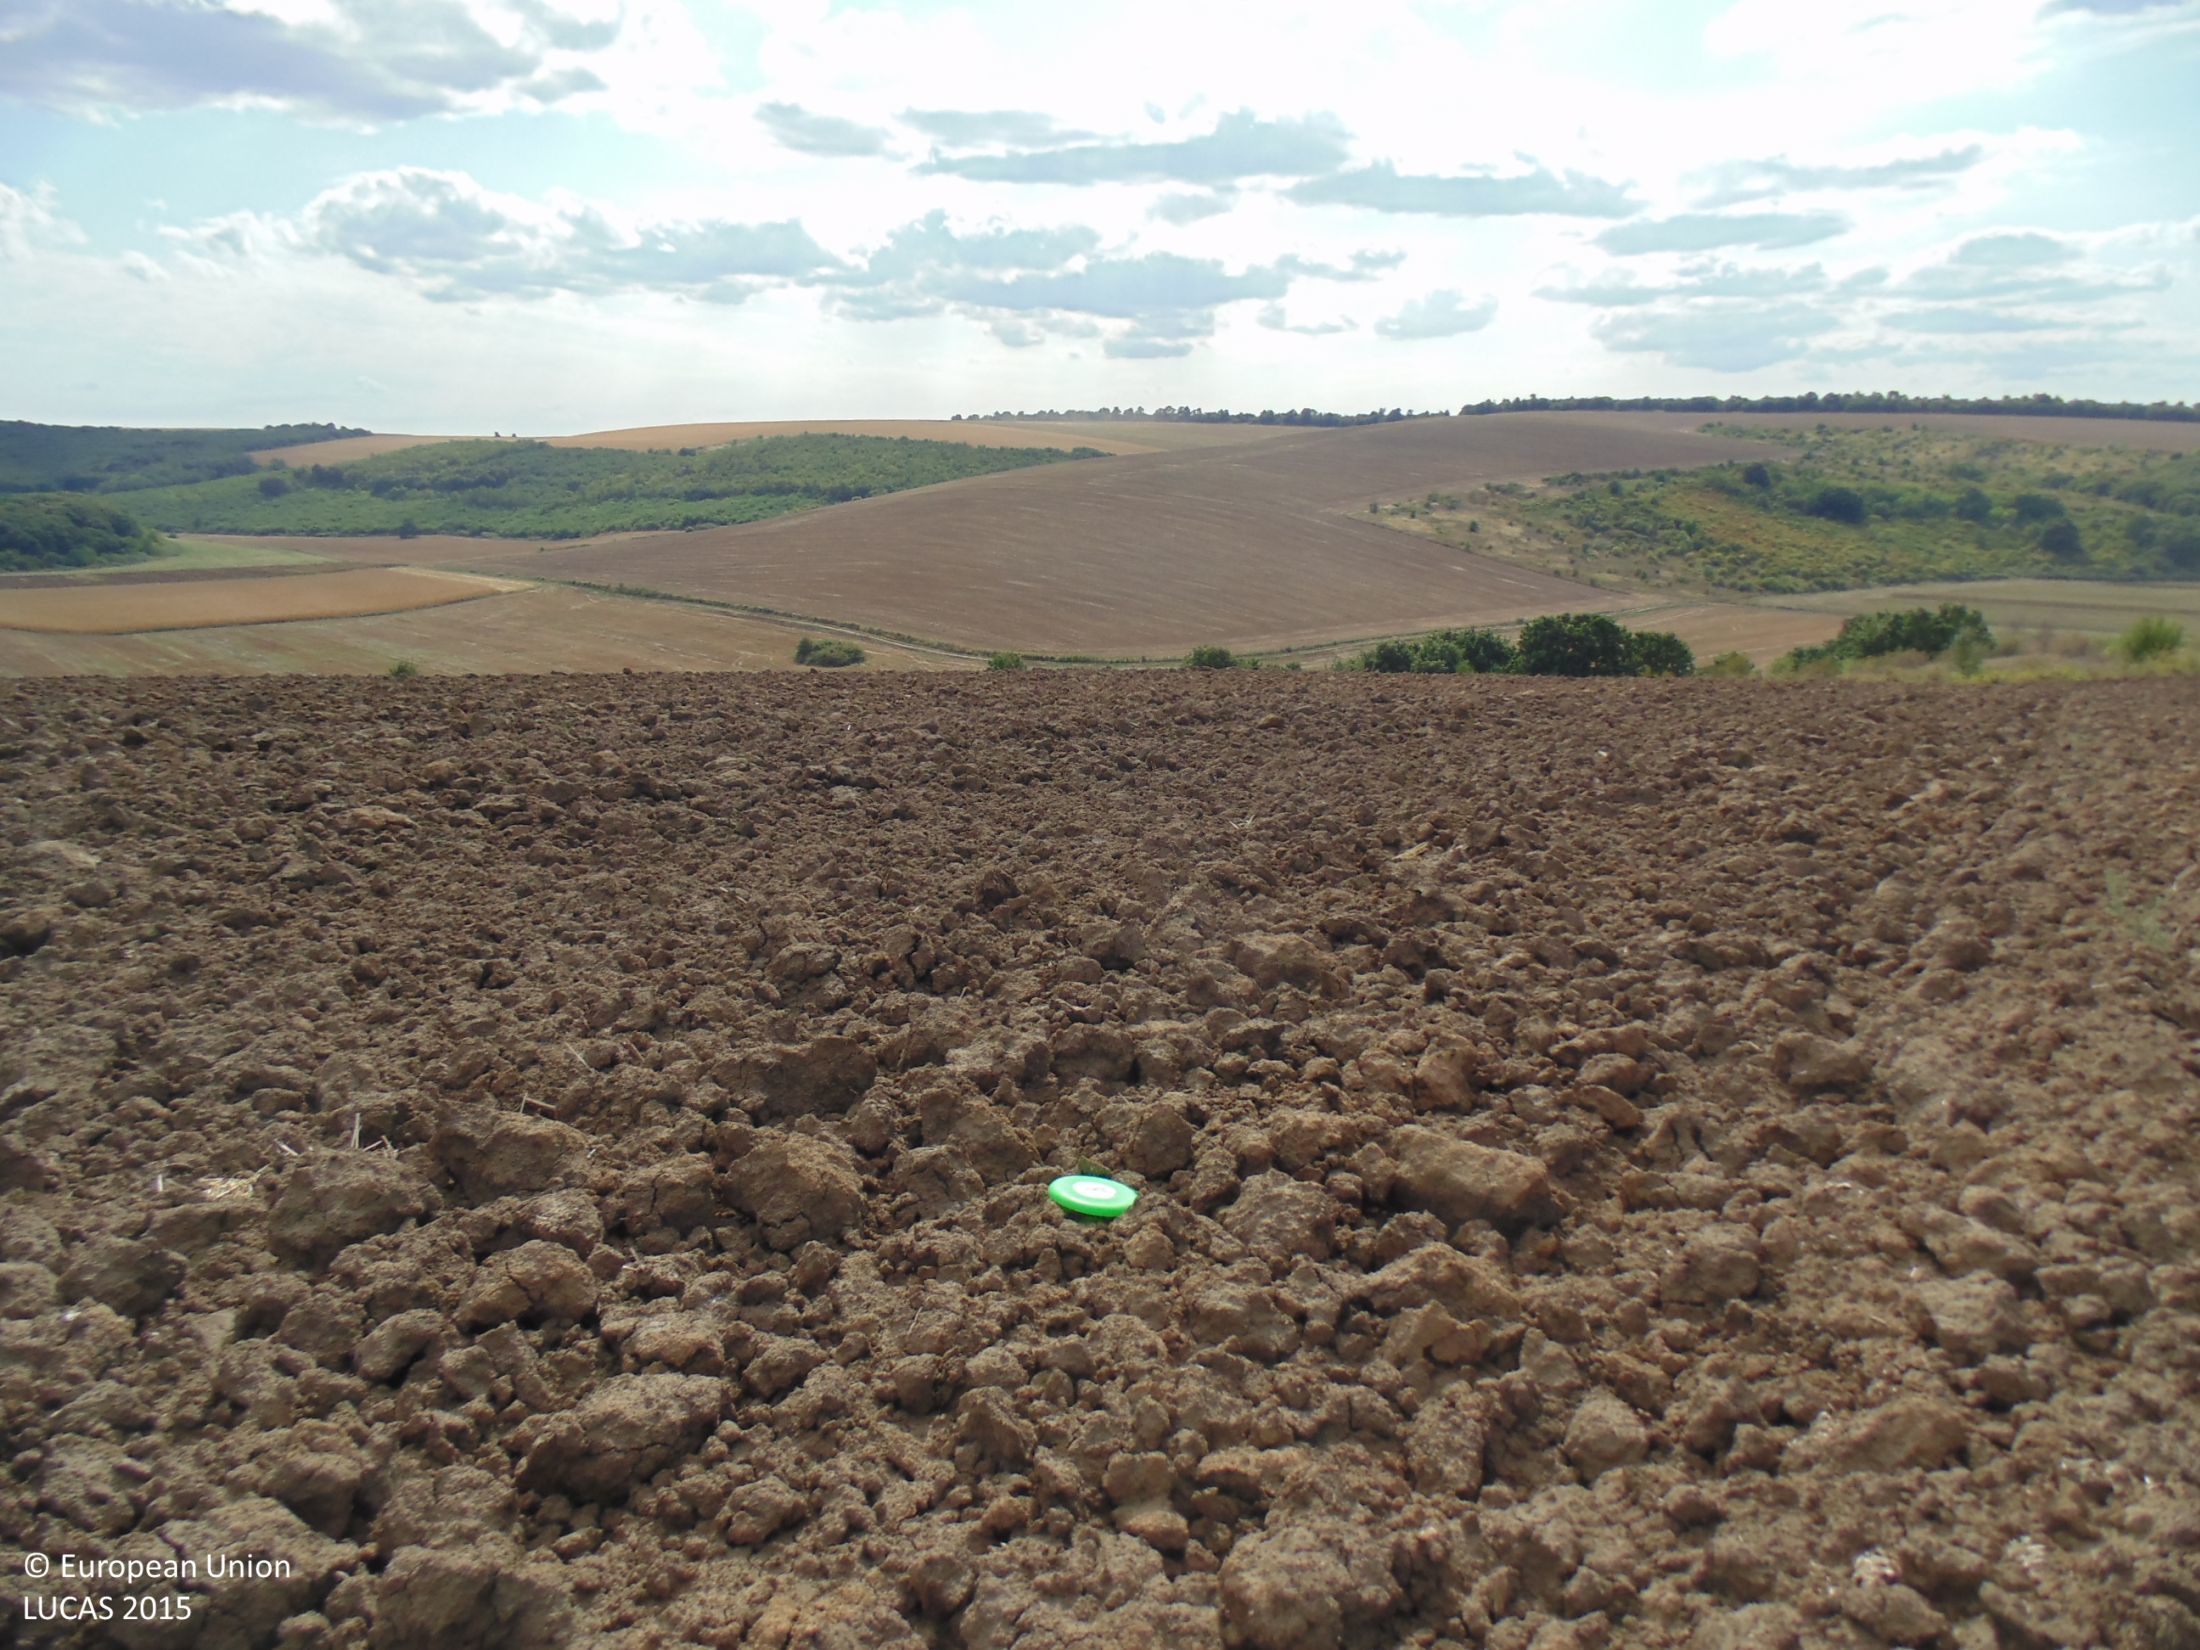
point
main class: Cropland
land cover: Common wheat
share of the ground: < 10 %
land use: Agriculture (excluding fallow land and kitchen gardens)
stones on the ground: < 10 %
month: September
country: BG
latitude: 44.0783
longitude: 27.0970
